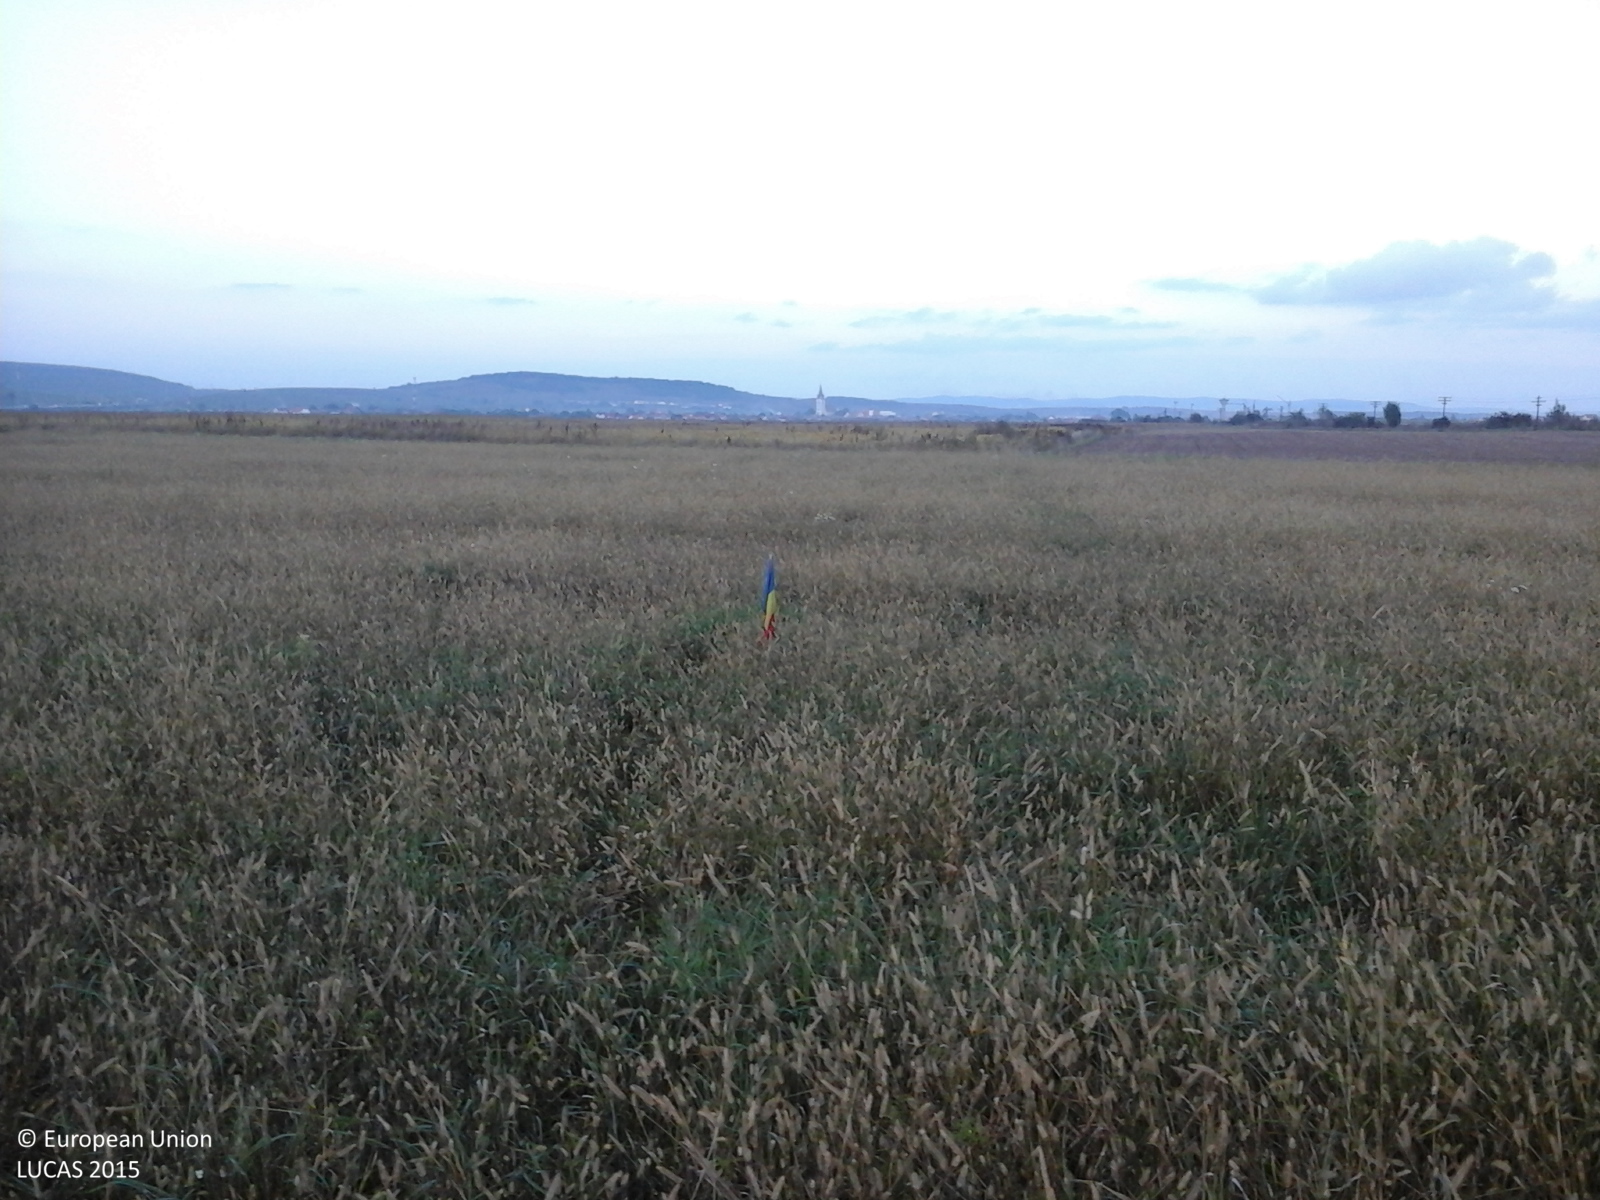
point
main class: Grassland
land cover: Grassland without tree/shrub cover
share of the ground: > 75 %
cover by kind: herbaceous plants 100 %
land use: Agriculture (excluding fallow land and kitchen gardens)
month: October
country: RO
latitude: 45.7722
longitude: 23.9990
